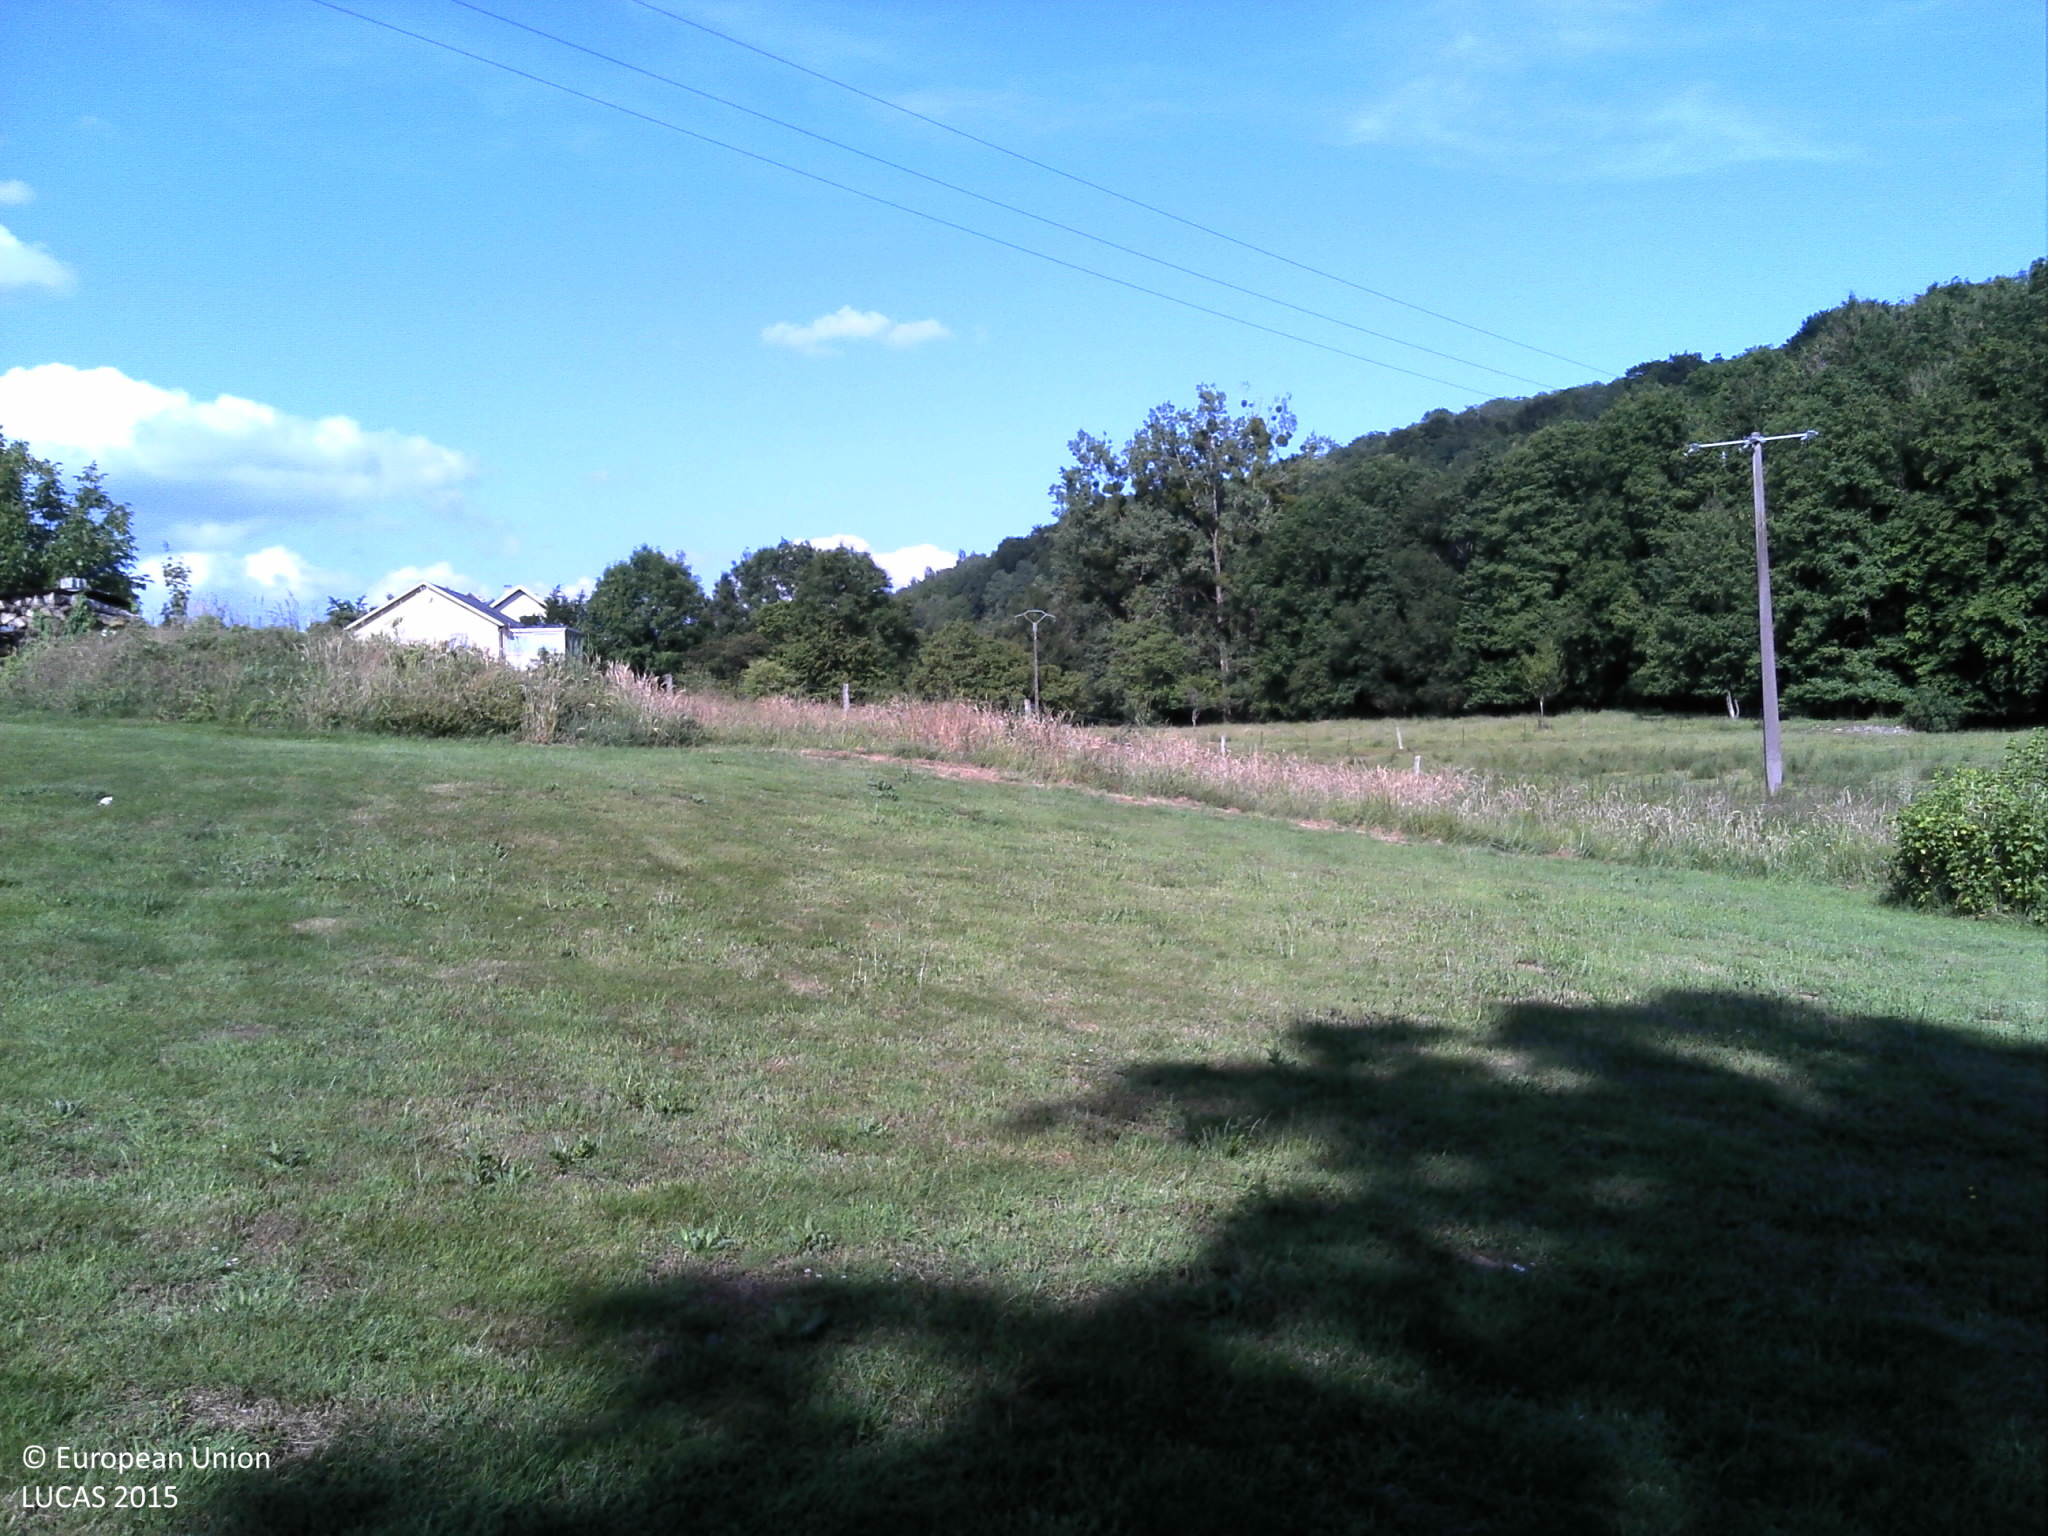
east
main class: Grassland
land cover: Grassland without tree/shrub cover
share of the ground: > 75 %
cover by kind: herbaceous plants 100 %
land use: Residential
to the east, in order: Fences; Grassland without tree/shrub cover; Fences; Grassland without tree/shrub cover; Electric lines; Grassland without tree/shrub cover; Fences; Broadleaved woodland; Rivers and streams; Broadleaved woodland; Fences; Grassland without tree/shrub cover
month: June
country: FR
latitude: 49.6983
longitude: 5.0480
